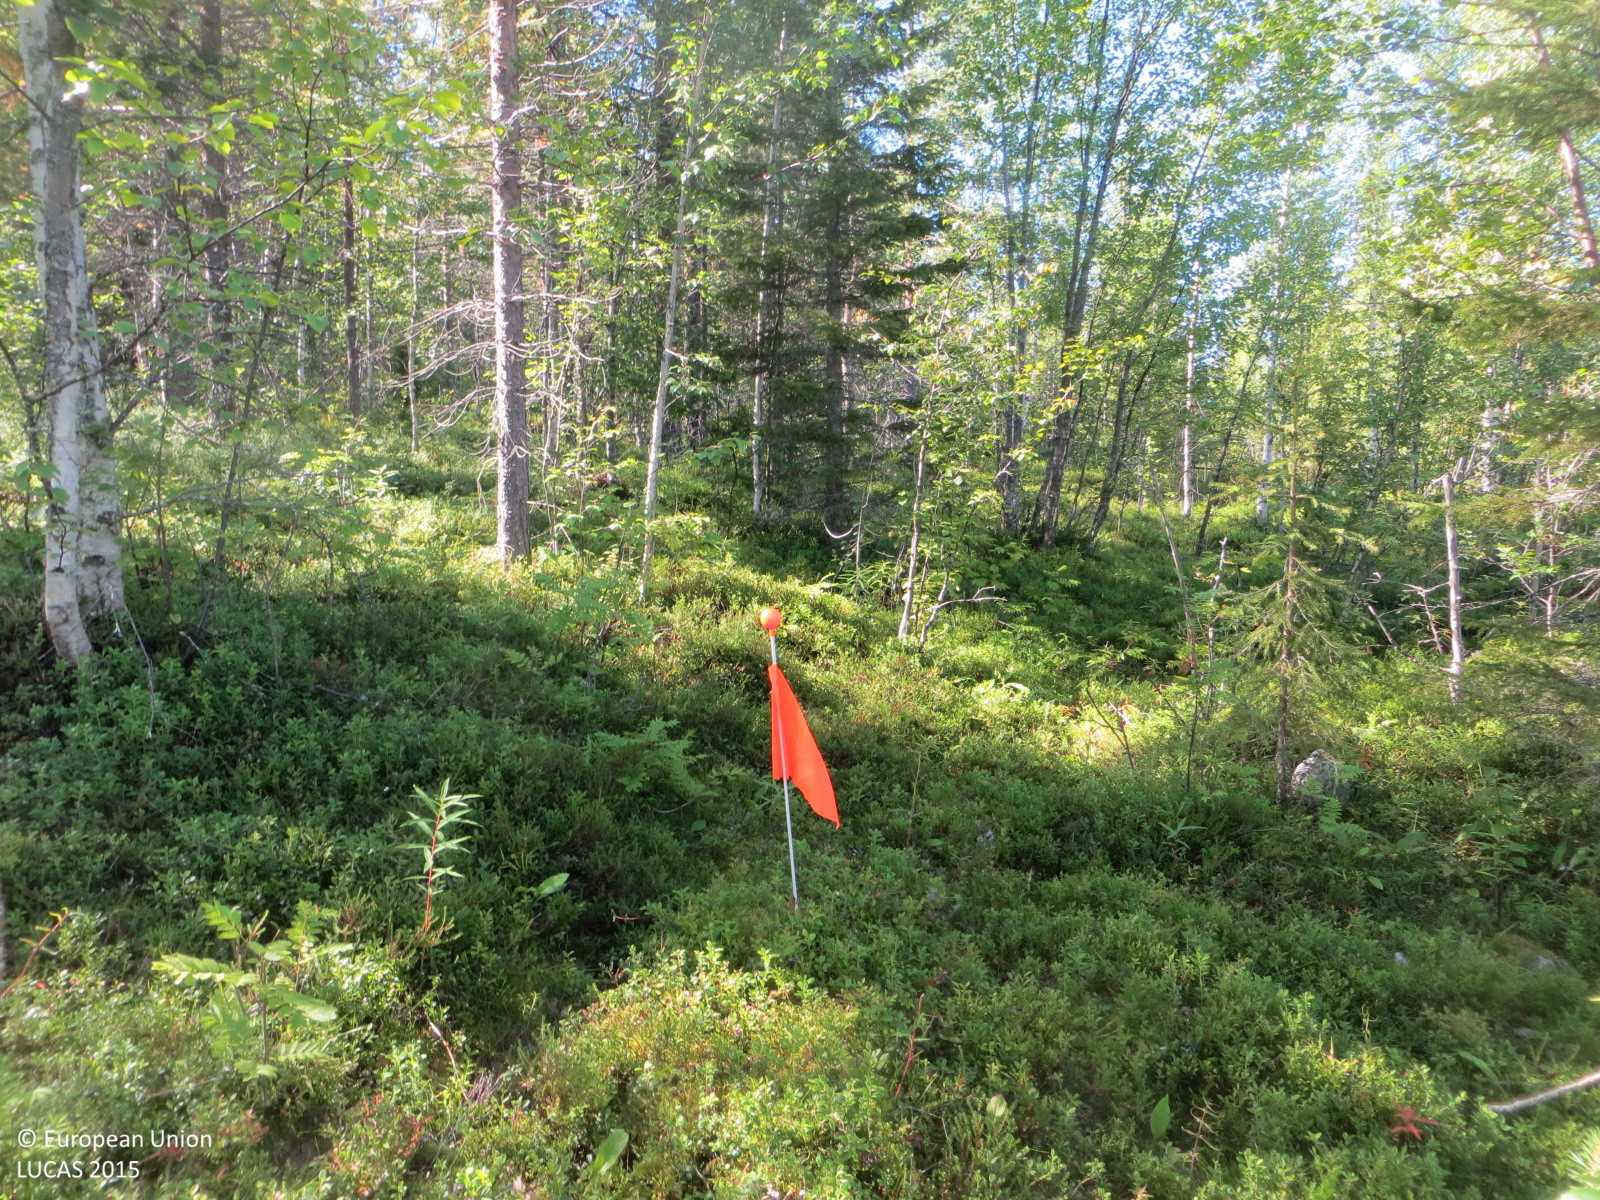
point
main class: Woodland
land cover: Pine dominated mixed woodland
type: boreal forest
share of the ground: 50 - 75 %
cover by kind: shrubs 40 %, broadleaved forest trees 35 %, coniferous forest trees 25 %
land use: Forestry
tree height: > 5 m
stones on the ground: 25 - 50 %
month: August
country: FI
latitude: 67.1941
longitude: 24.1083
